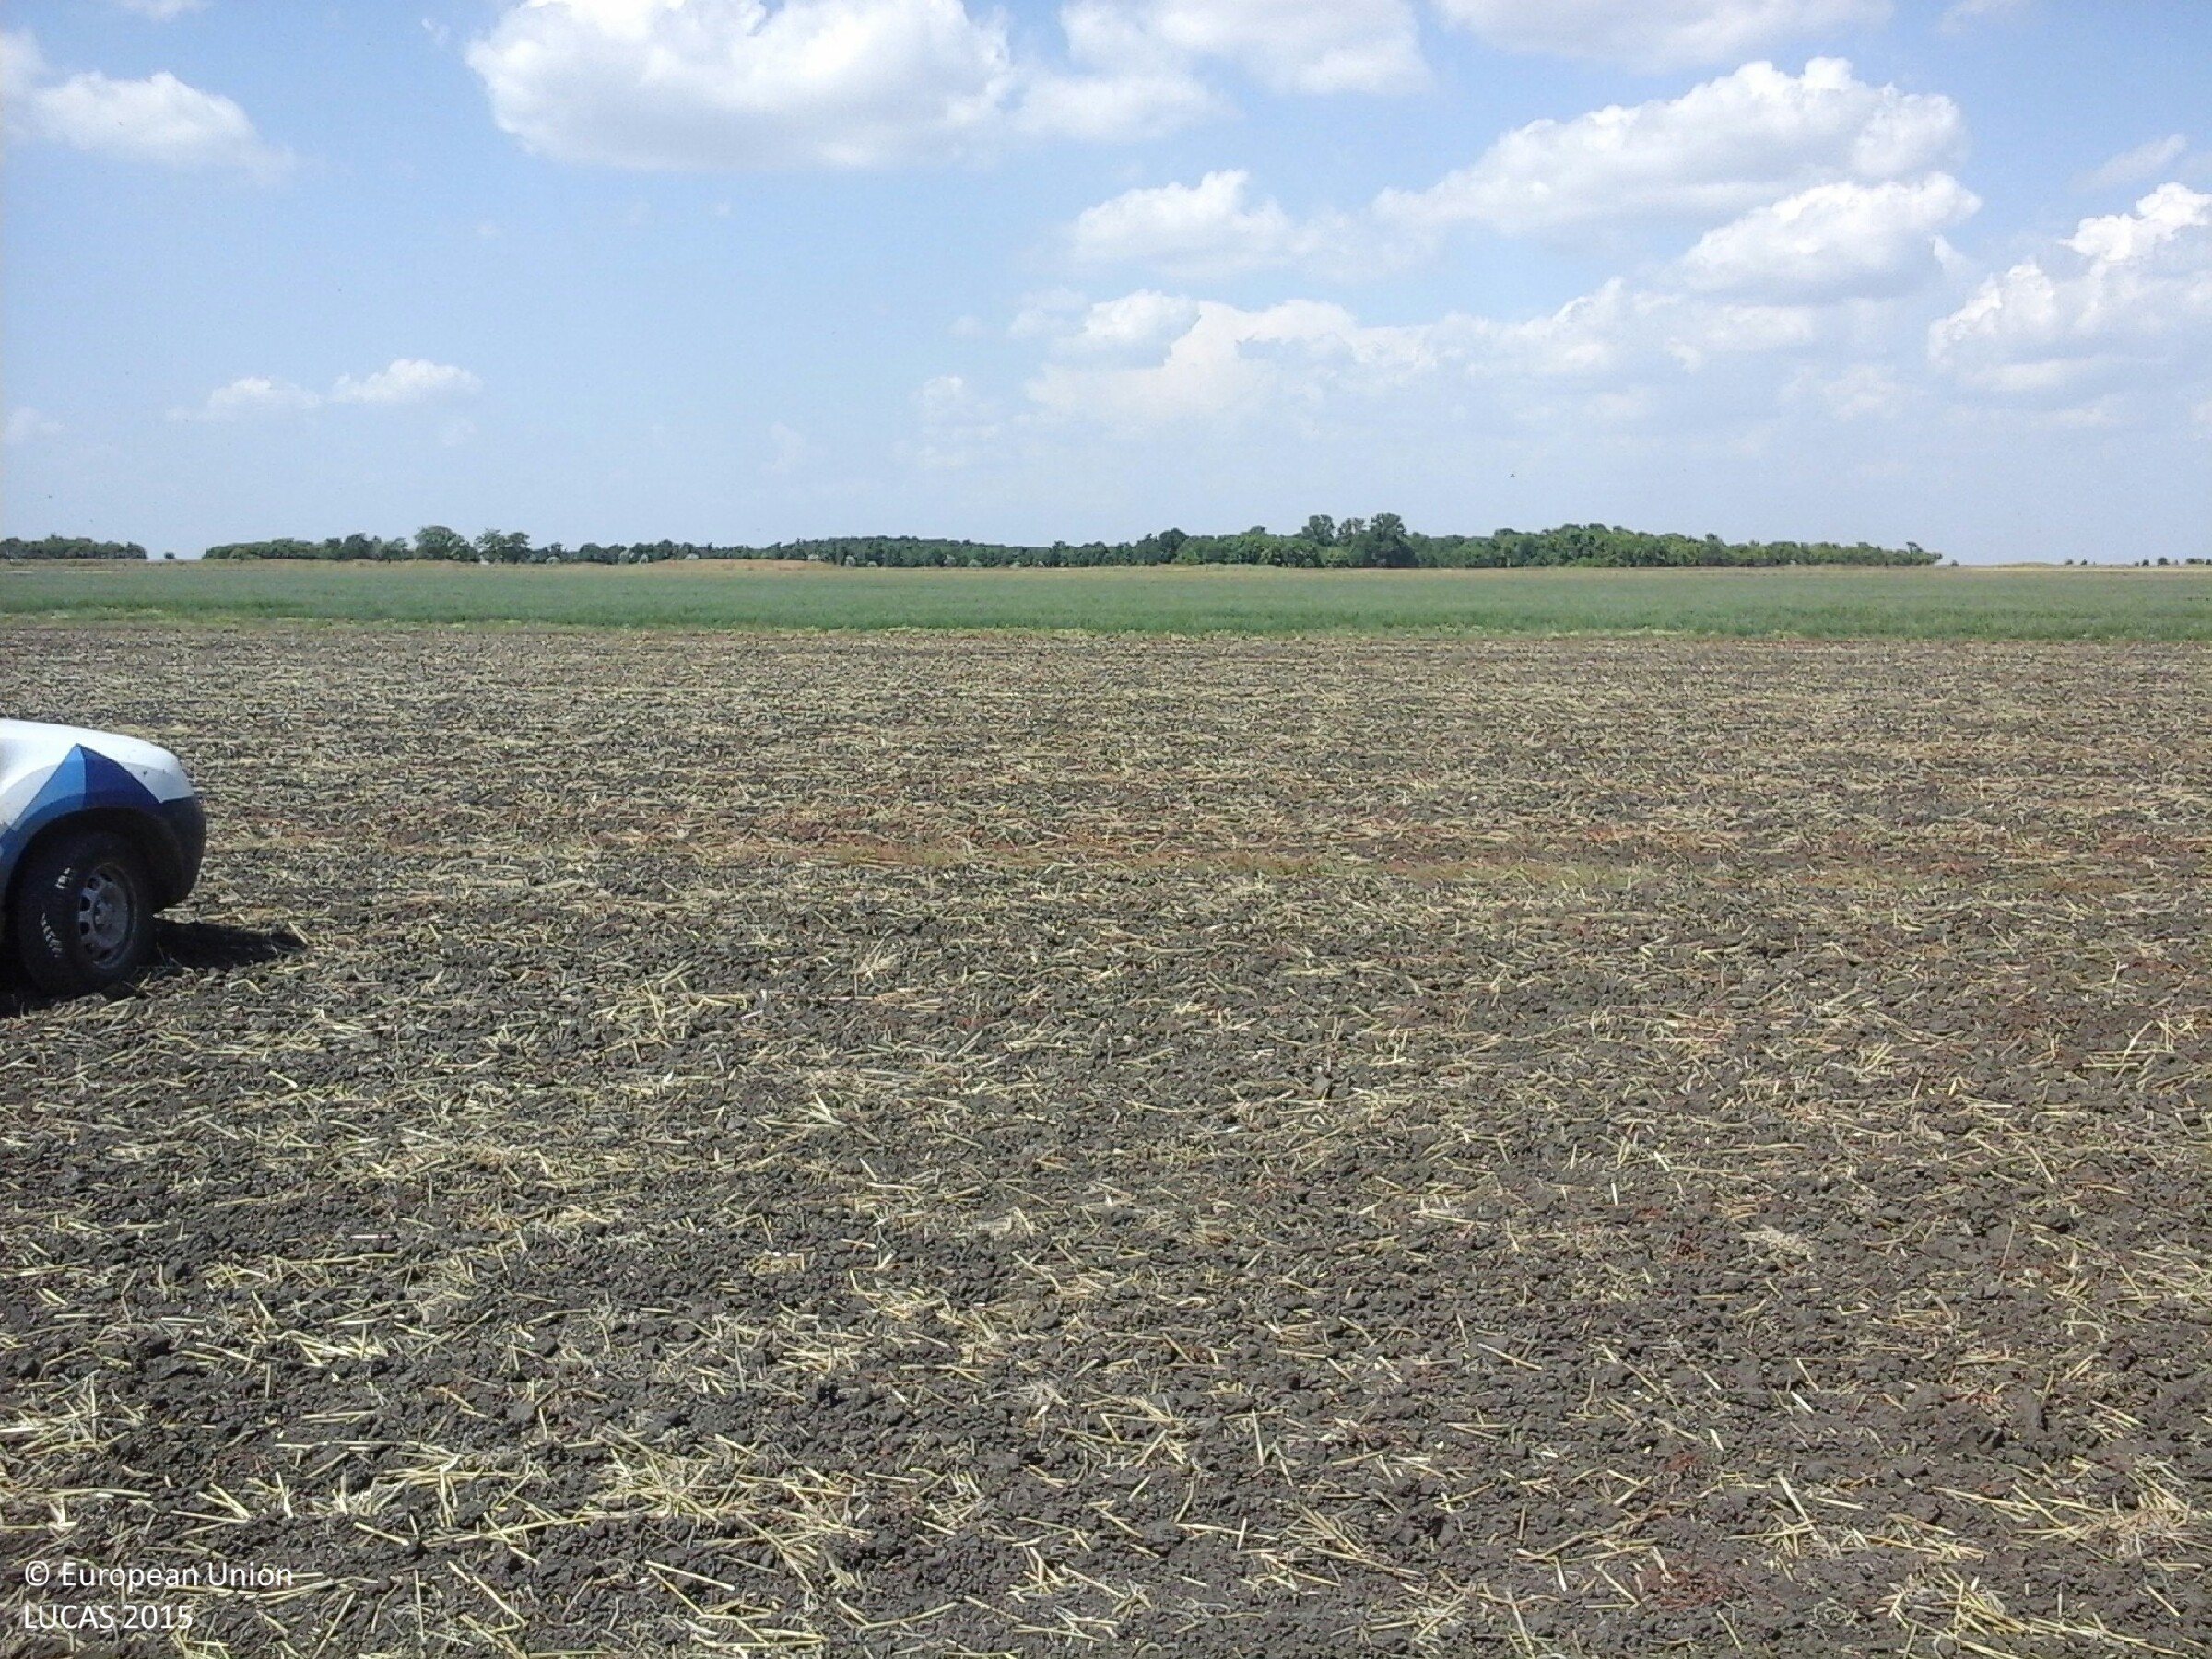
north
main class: Cropland
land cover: Common wheat
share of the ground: < 10 %
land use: Agriculture (excluding fallow land and kitchen gardens)
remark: Harvested field
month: August
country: HU
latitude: 47.3817
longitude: 20.9901
